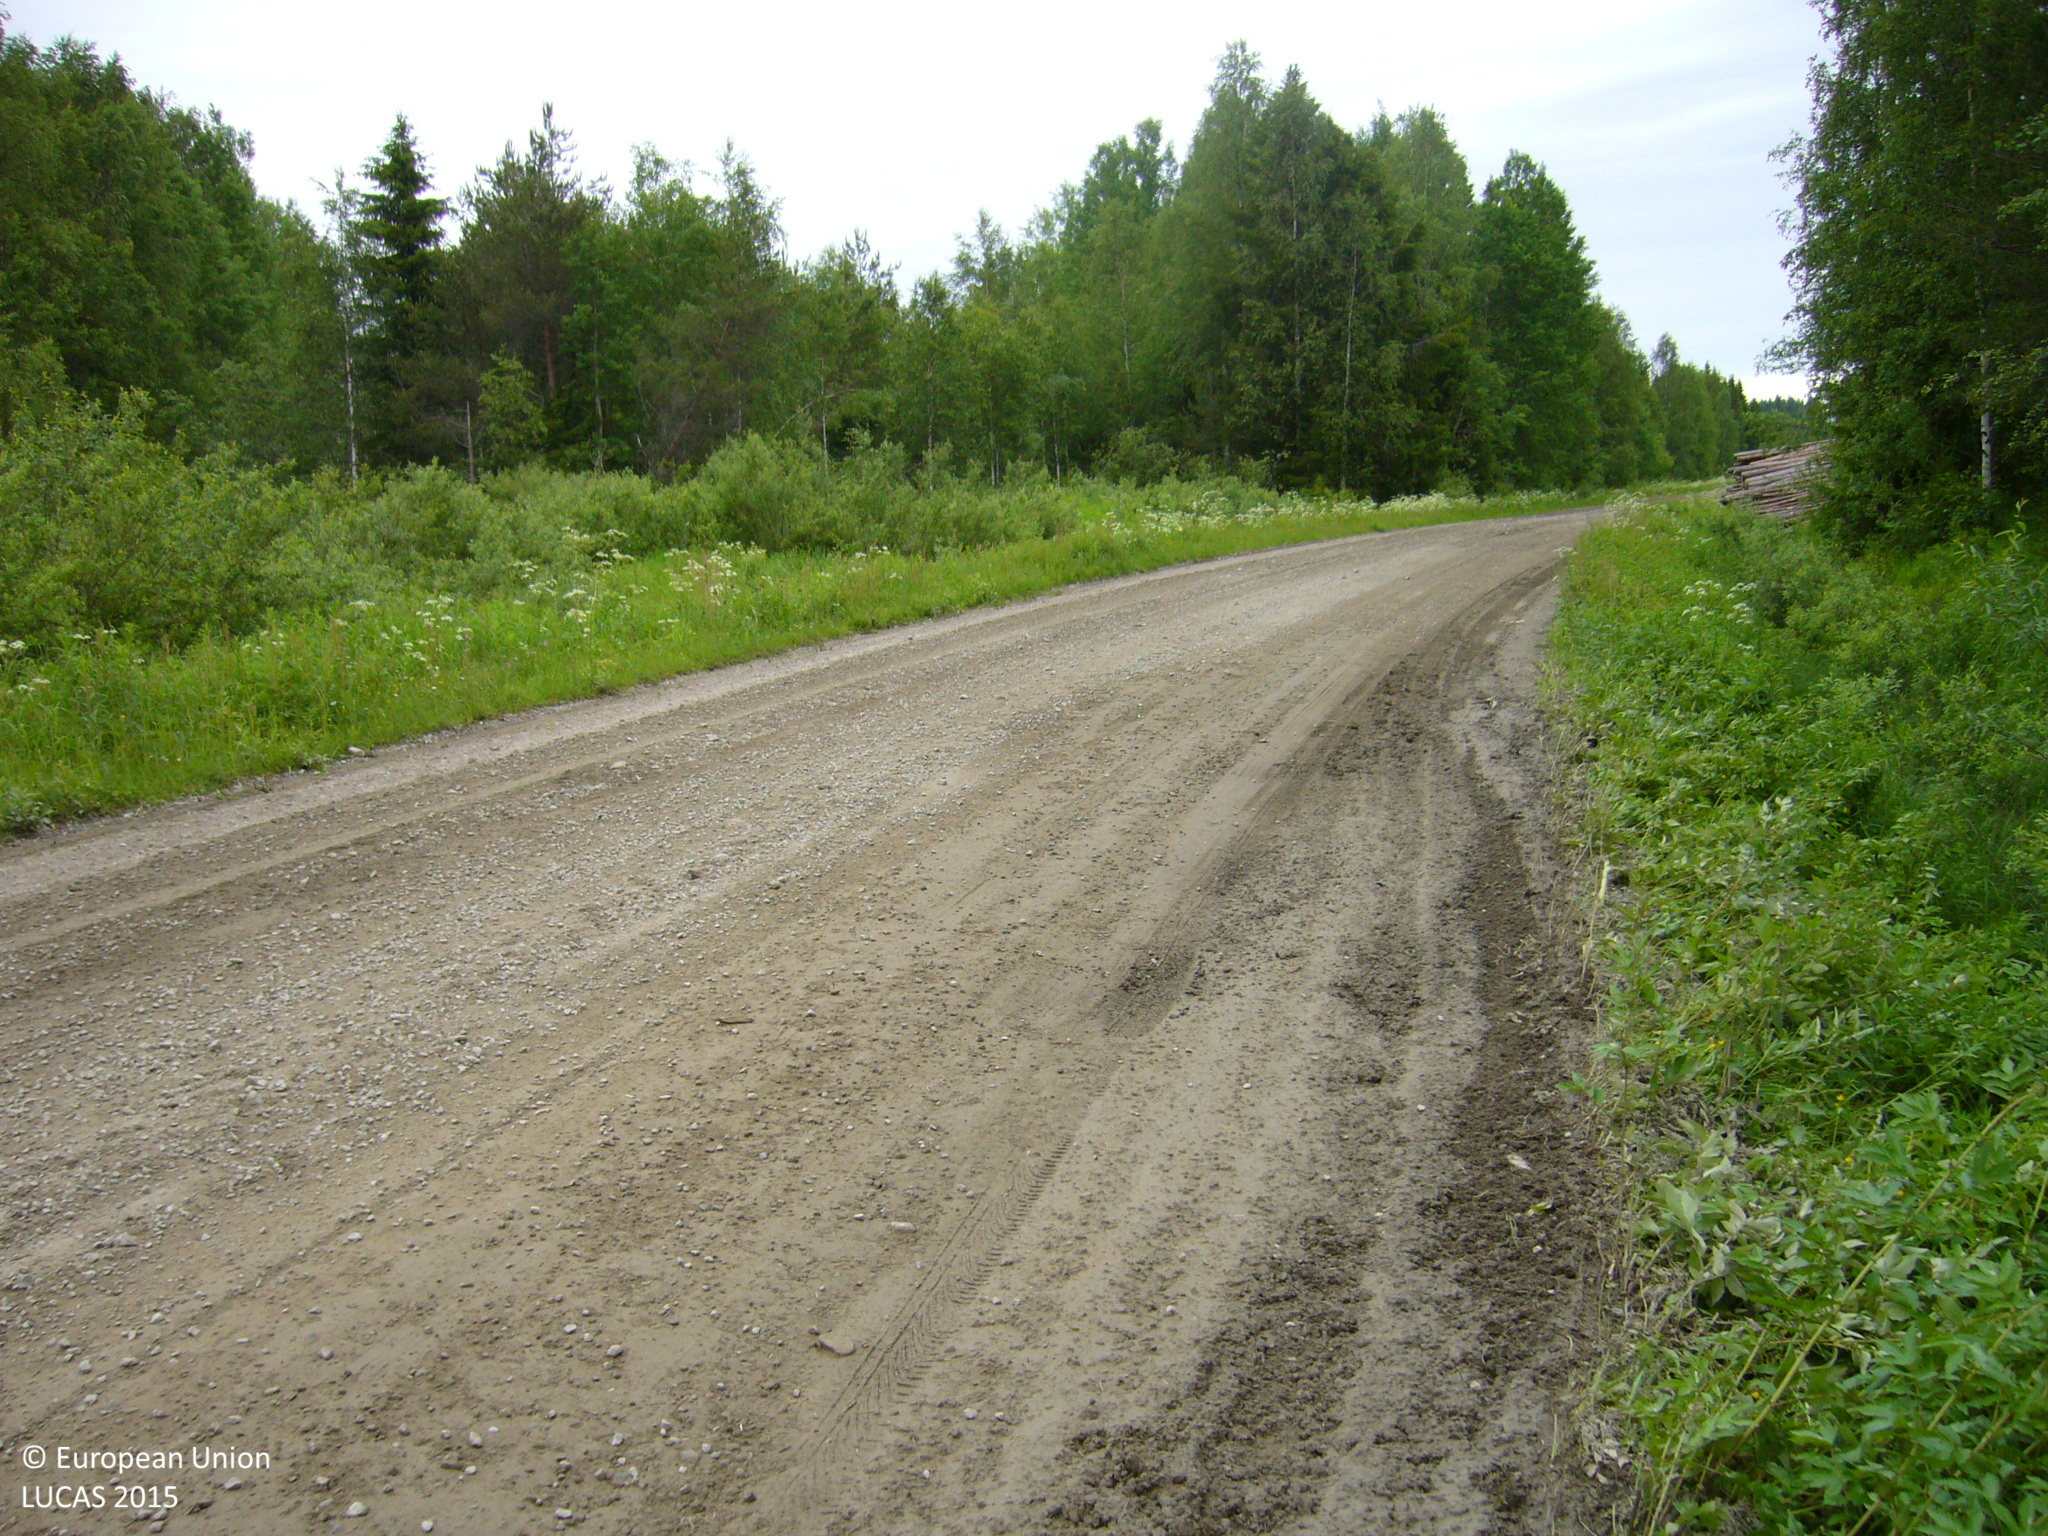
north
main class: Woodland
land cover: Other mixed woodland
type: boreal forest
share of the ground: > 75 %
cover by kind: broadleaved forest trees 50 %, coniferous forest trees 25 %, herbaceous plants 20 %, shrubs 5 %
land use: Forestry
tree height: > 5 m
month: July
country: FI
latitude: 63.4714
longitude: 26.4817
